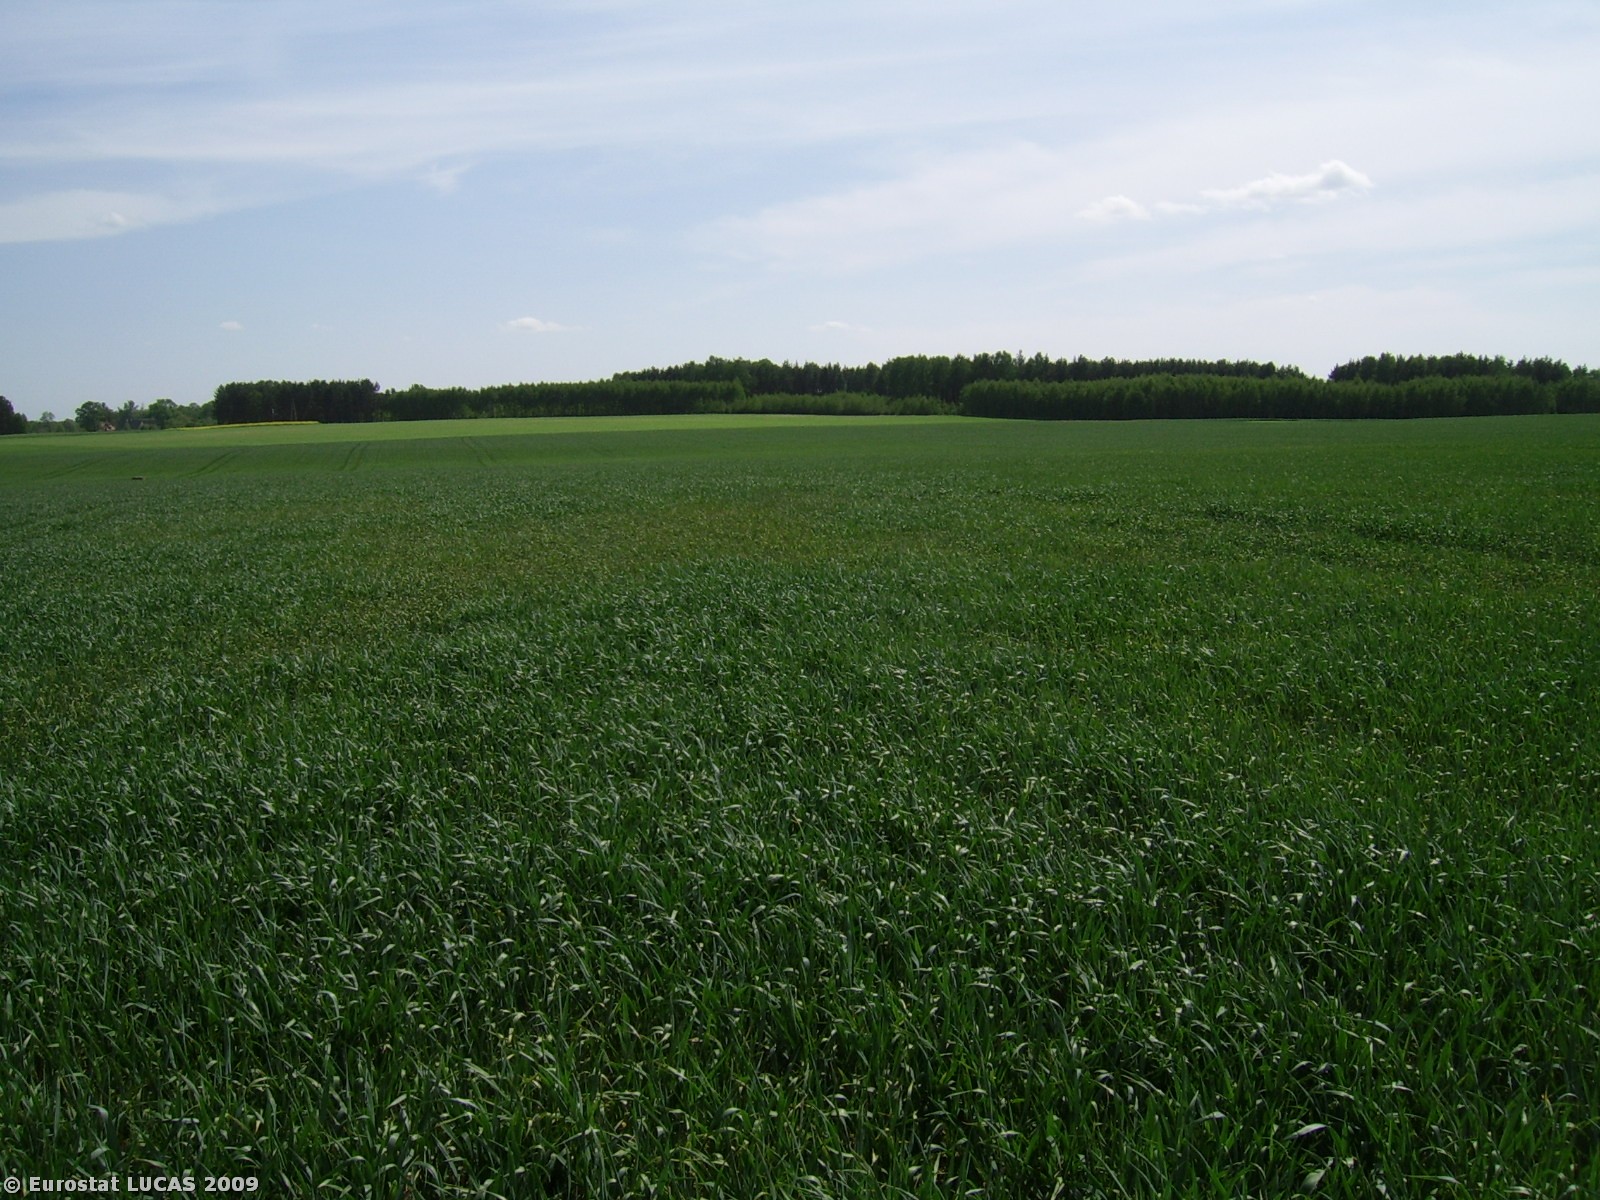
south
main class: Cropland
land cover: Common wheat
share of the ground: > 75 %
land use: Agriculture (excluding fallow land and kitchen gardens)
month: May
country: PL
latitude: 52.7290
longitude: 17.6094
